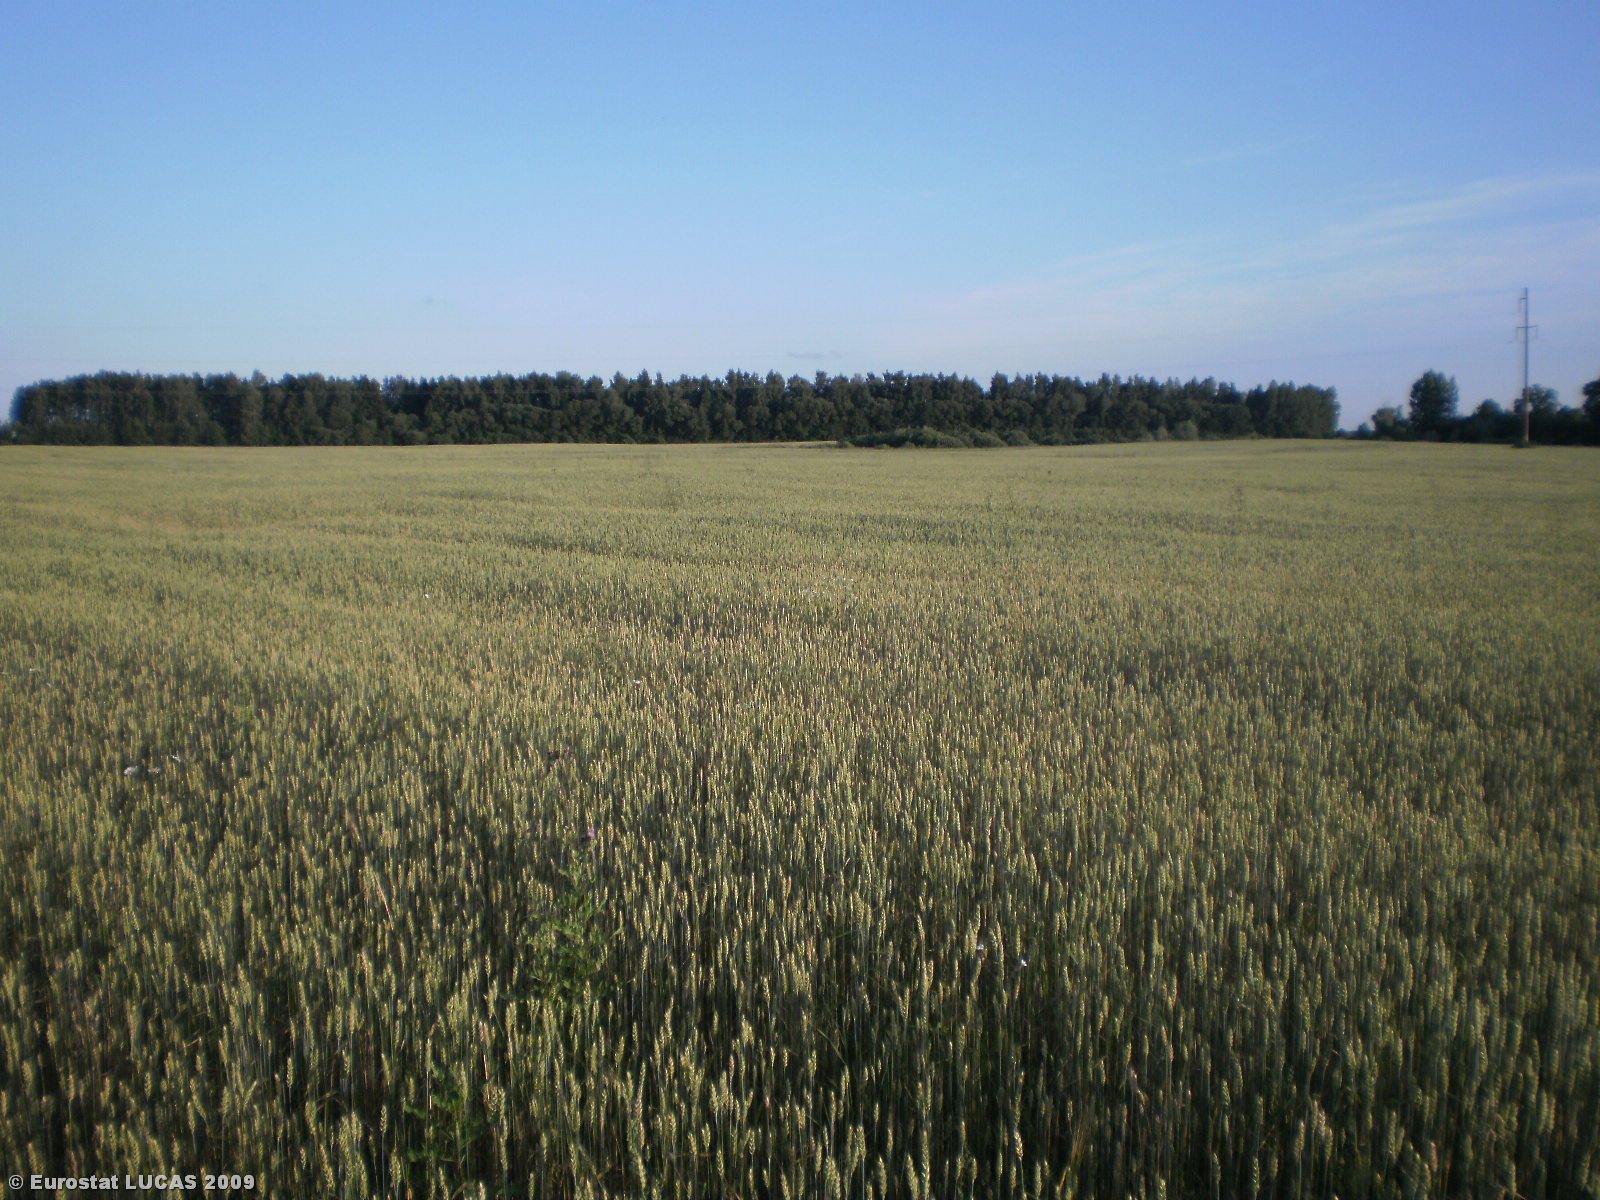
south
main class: Cropland
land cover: Common wheat
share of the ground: > 75 %
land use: Agriculture (excluding fallow land and kitchen gardens)
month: July
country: LT
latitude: 55.8733
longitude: 25.2519
